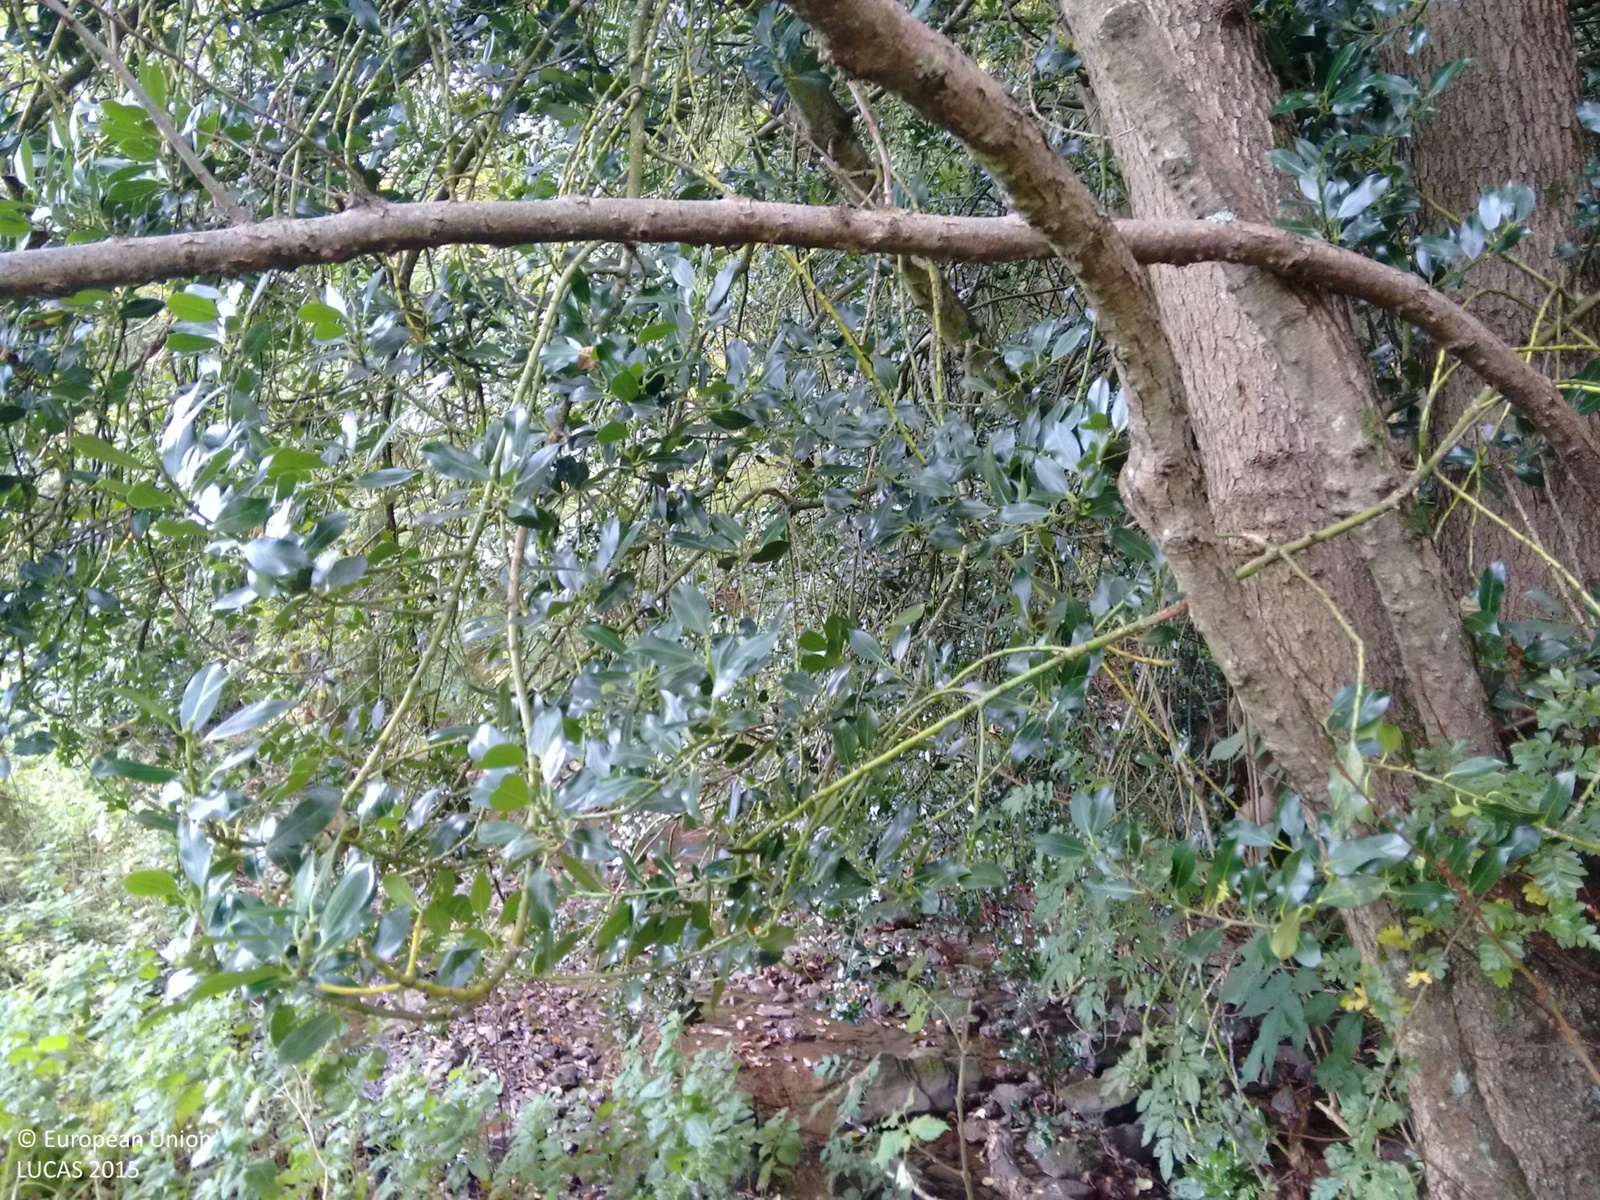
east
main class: Woodland
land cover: Broadleaved woodland
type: mesophytic deciduous forest
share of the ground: > 75 %
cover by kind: broadleaved forest trees 80 %, shrubs 10 %, herbaceous plants 10 %
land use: Semi-natural and natural areas not in use
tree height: > 5 m
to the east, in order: Broadleaved woodland; Rivers and streams; Broadleaved woodland; Fences; Broadleaved woodland; Fences; Grassland with sparse tree/shrub cover; Single bushes/trees; Fences; Grassland without tree/shrub cover; Electric lines; Grassland without tree/shrub cover
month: October
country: GB
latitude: 51.7688
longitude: -2.6620
